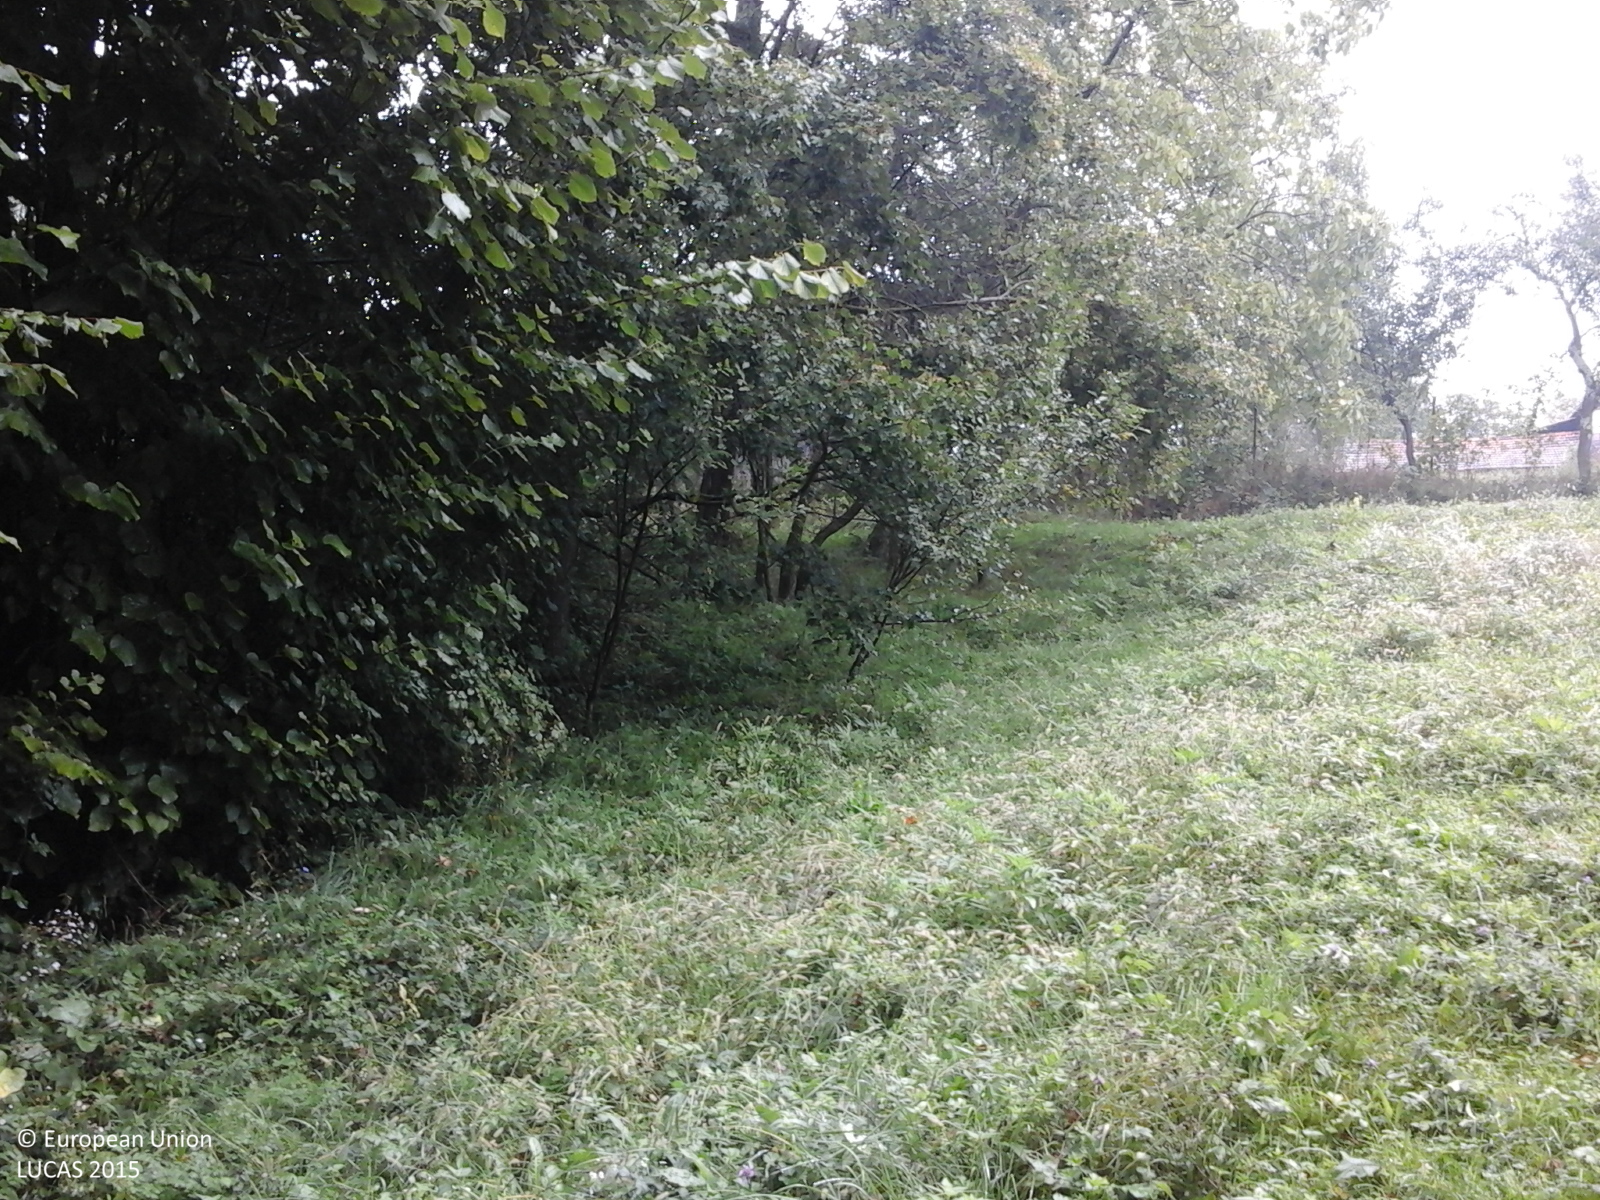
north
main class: Woodland
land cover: Broadleaved woodland
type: exotic forest
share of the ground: > 75 %
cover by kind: broadleaved forest trees 100 %
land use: Forestry
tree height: > 5 m
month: September
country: RO
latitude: 47.0304
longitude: 22.5426
